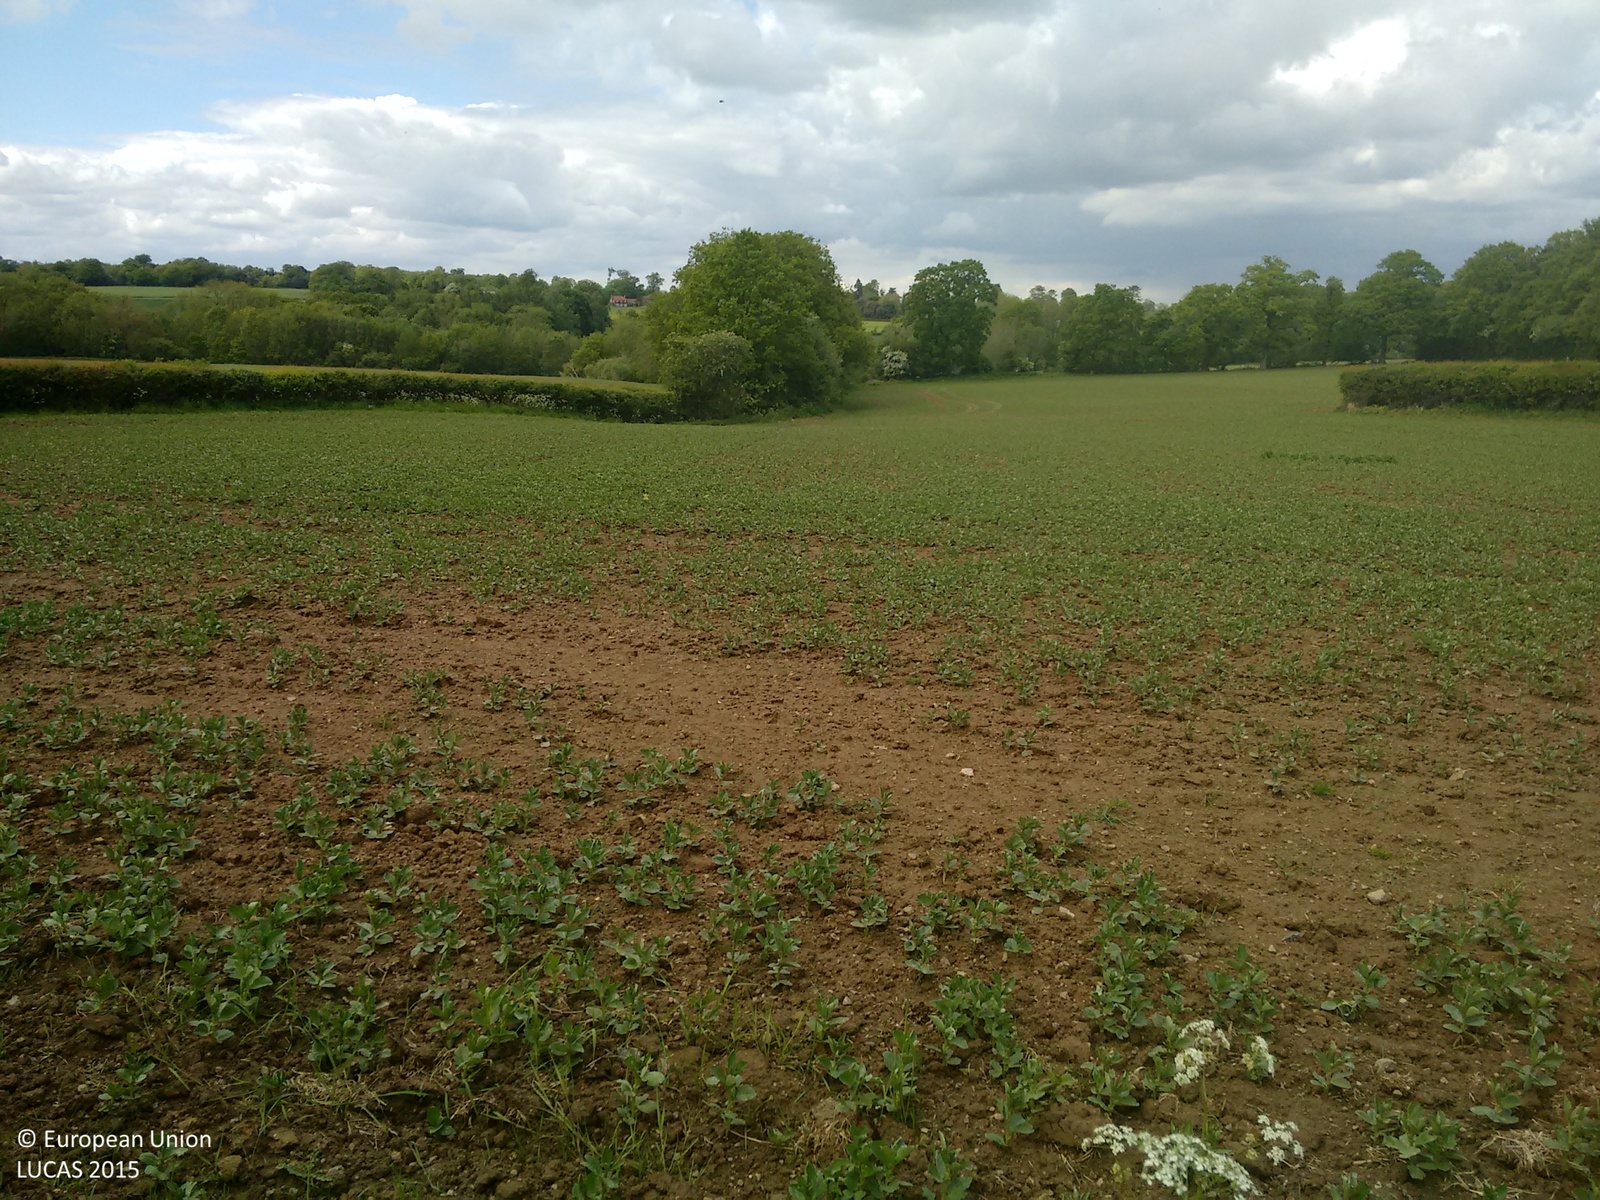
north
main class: Cropland
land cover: Dry pulses
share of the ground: 50 - 75 %
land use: Agriculture (excluding fallow land and kitchen gardens)
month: May
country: GB
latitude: 51.1514
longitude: 0.1470
